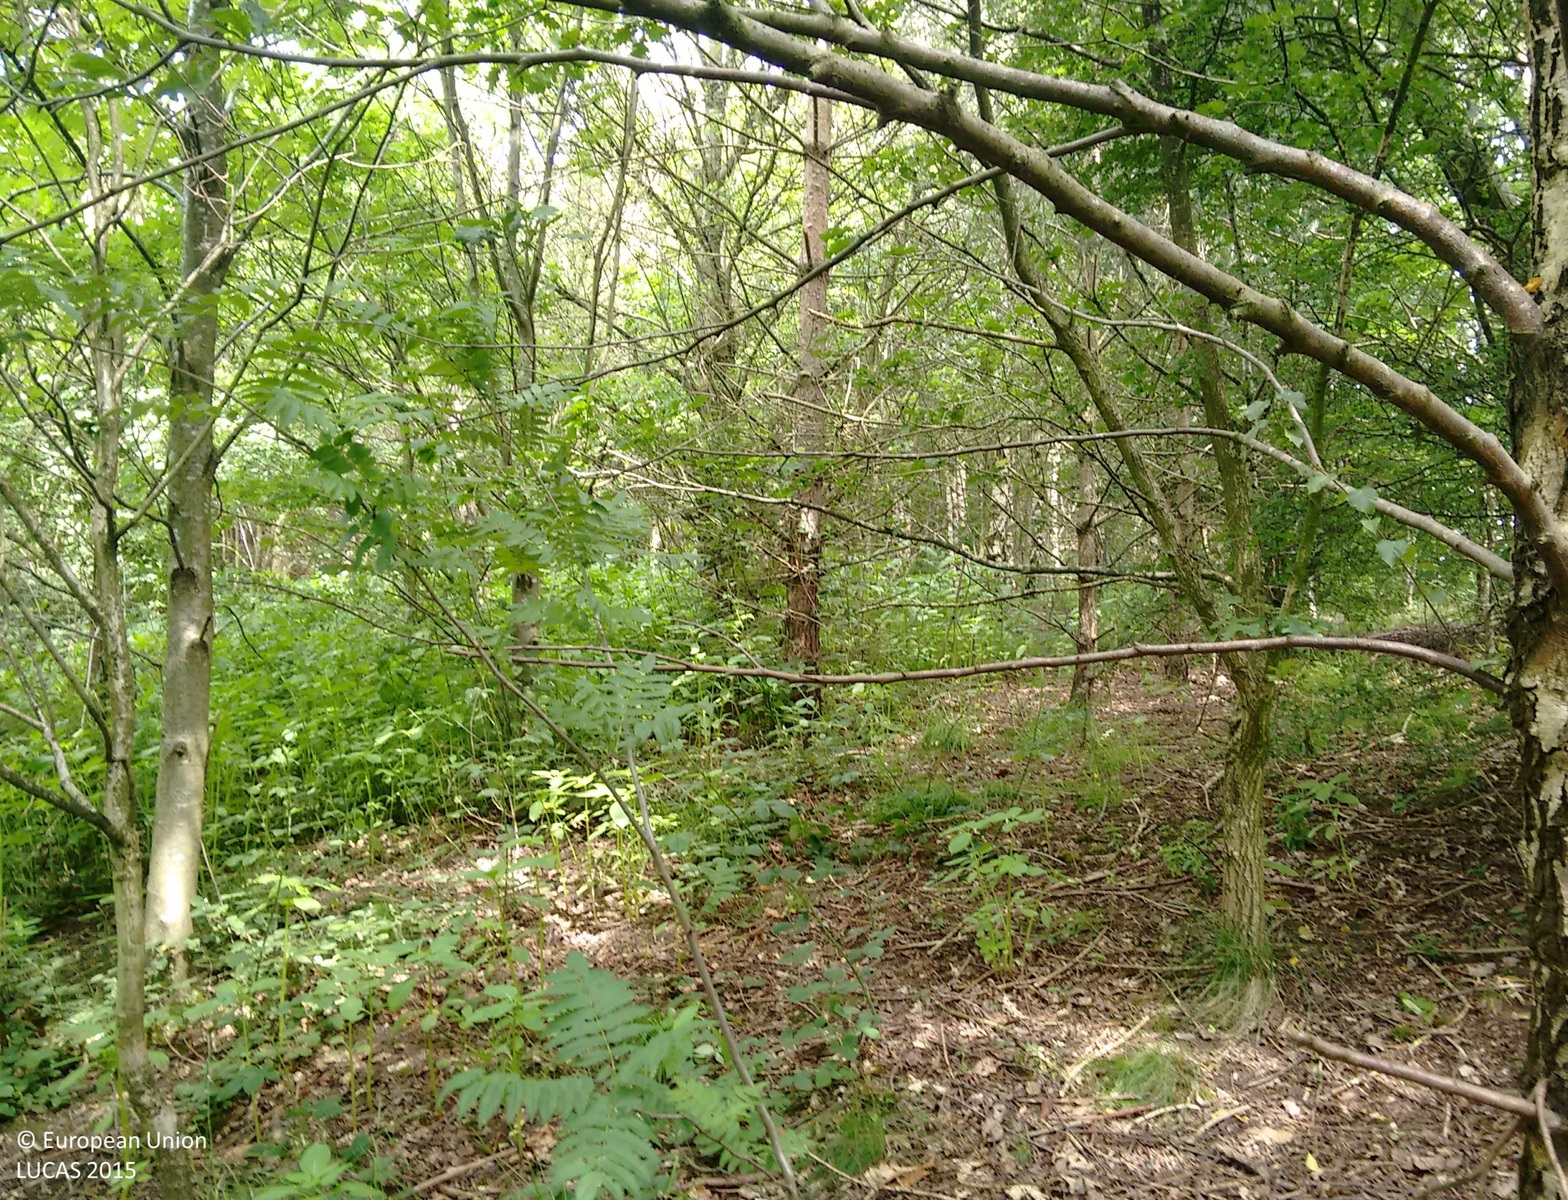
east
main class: Woodland
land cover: Broadleaved woodland
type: mesophytic deciduous forest
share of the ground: > 75 %
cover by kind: broadleaved forest trees 100 %
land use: Sport
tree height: > 5 m
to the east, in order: Broadleaved woodland; Grassland without tree/shrub cover; Broadleaved woodland
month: June
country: GB
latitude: 53.4984
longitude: -2.1345
